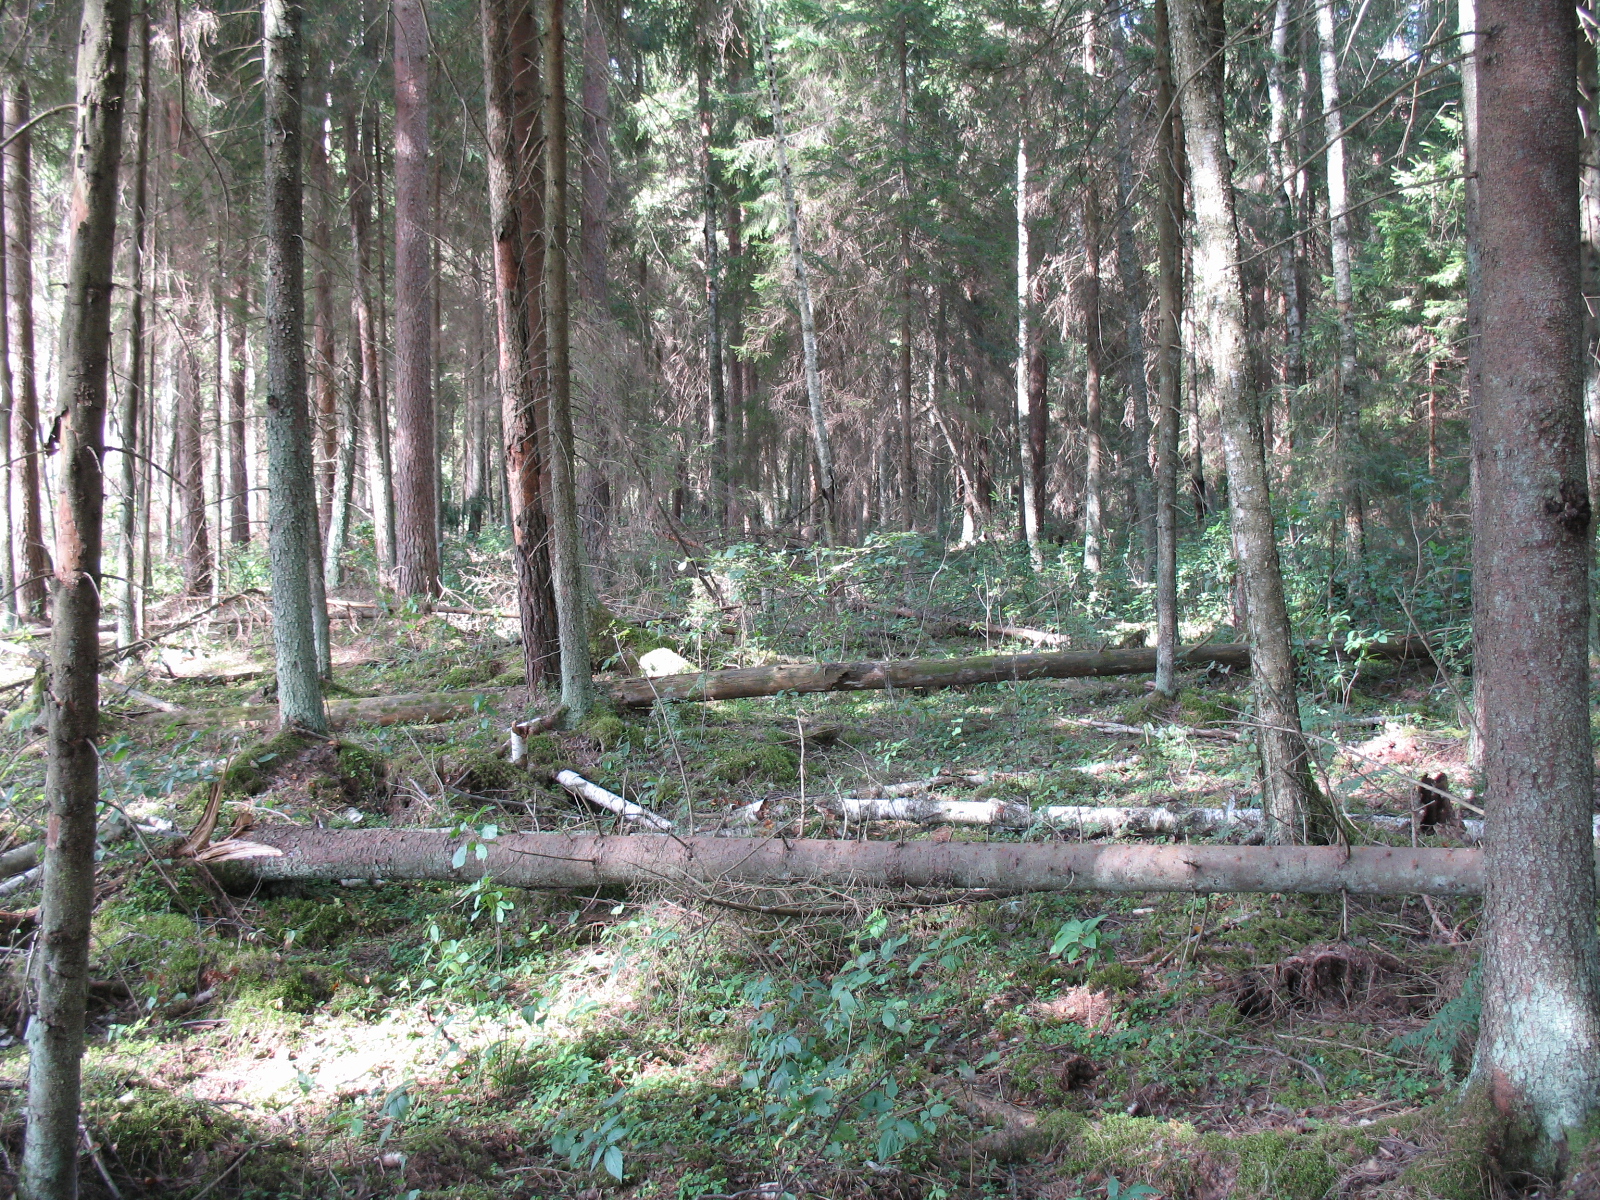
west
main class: Woodland
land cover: Other mixed woodland
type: hemiboreal forest and nemoral coniferous forest and mixed broadleaved-coniferous forest
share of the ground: > 75 %
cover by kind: coniferous forest trees 50 %, broadleaved forest trees 30 %, lichens and mosses 15 %, shrubs 5 %
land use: Forestry
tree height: > 5 m
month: August
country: LV
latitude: 56.4488
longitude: 25.6502
